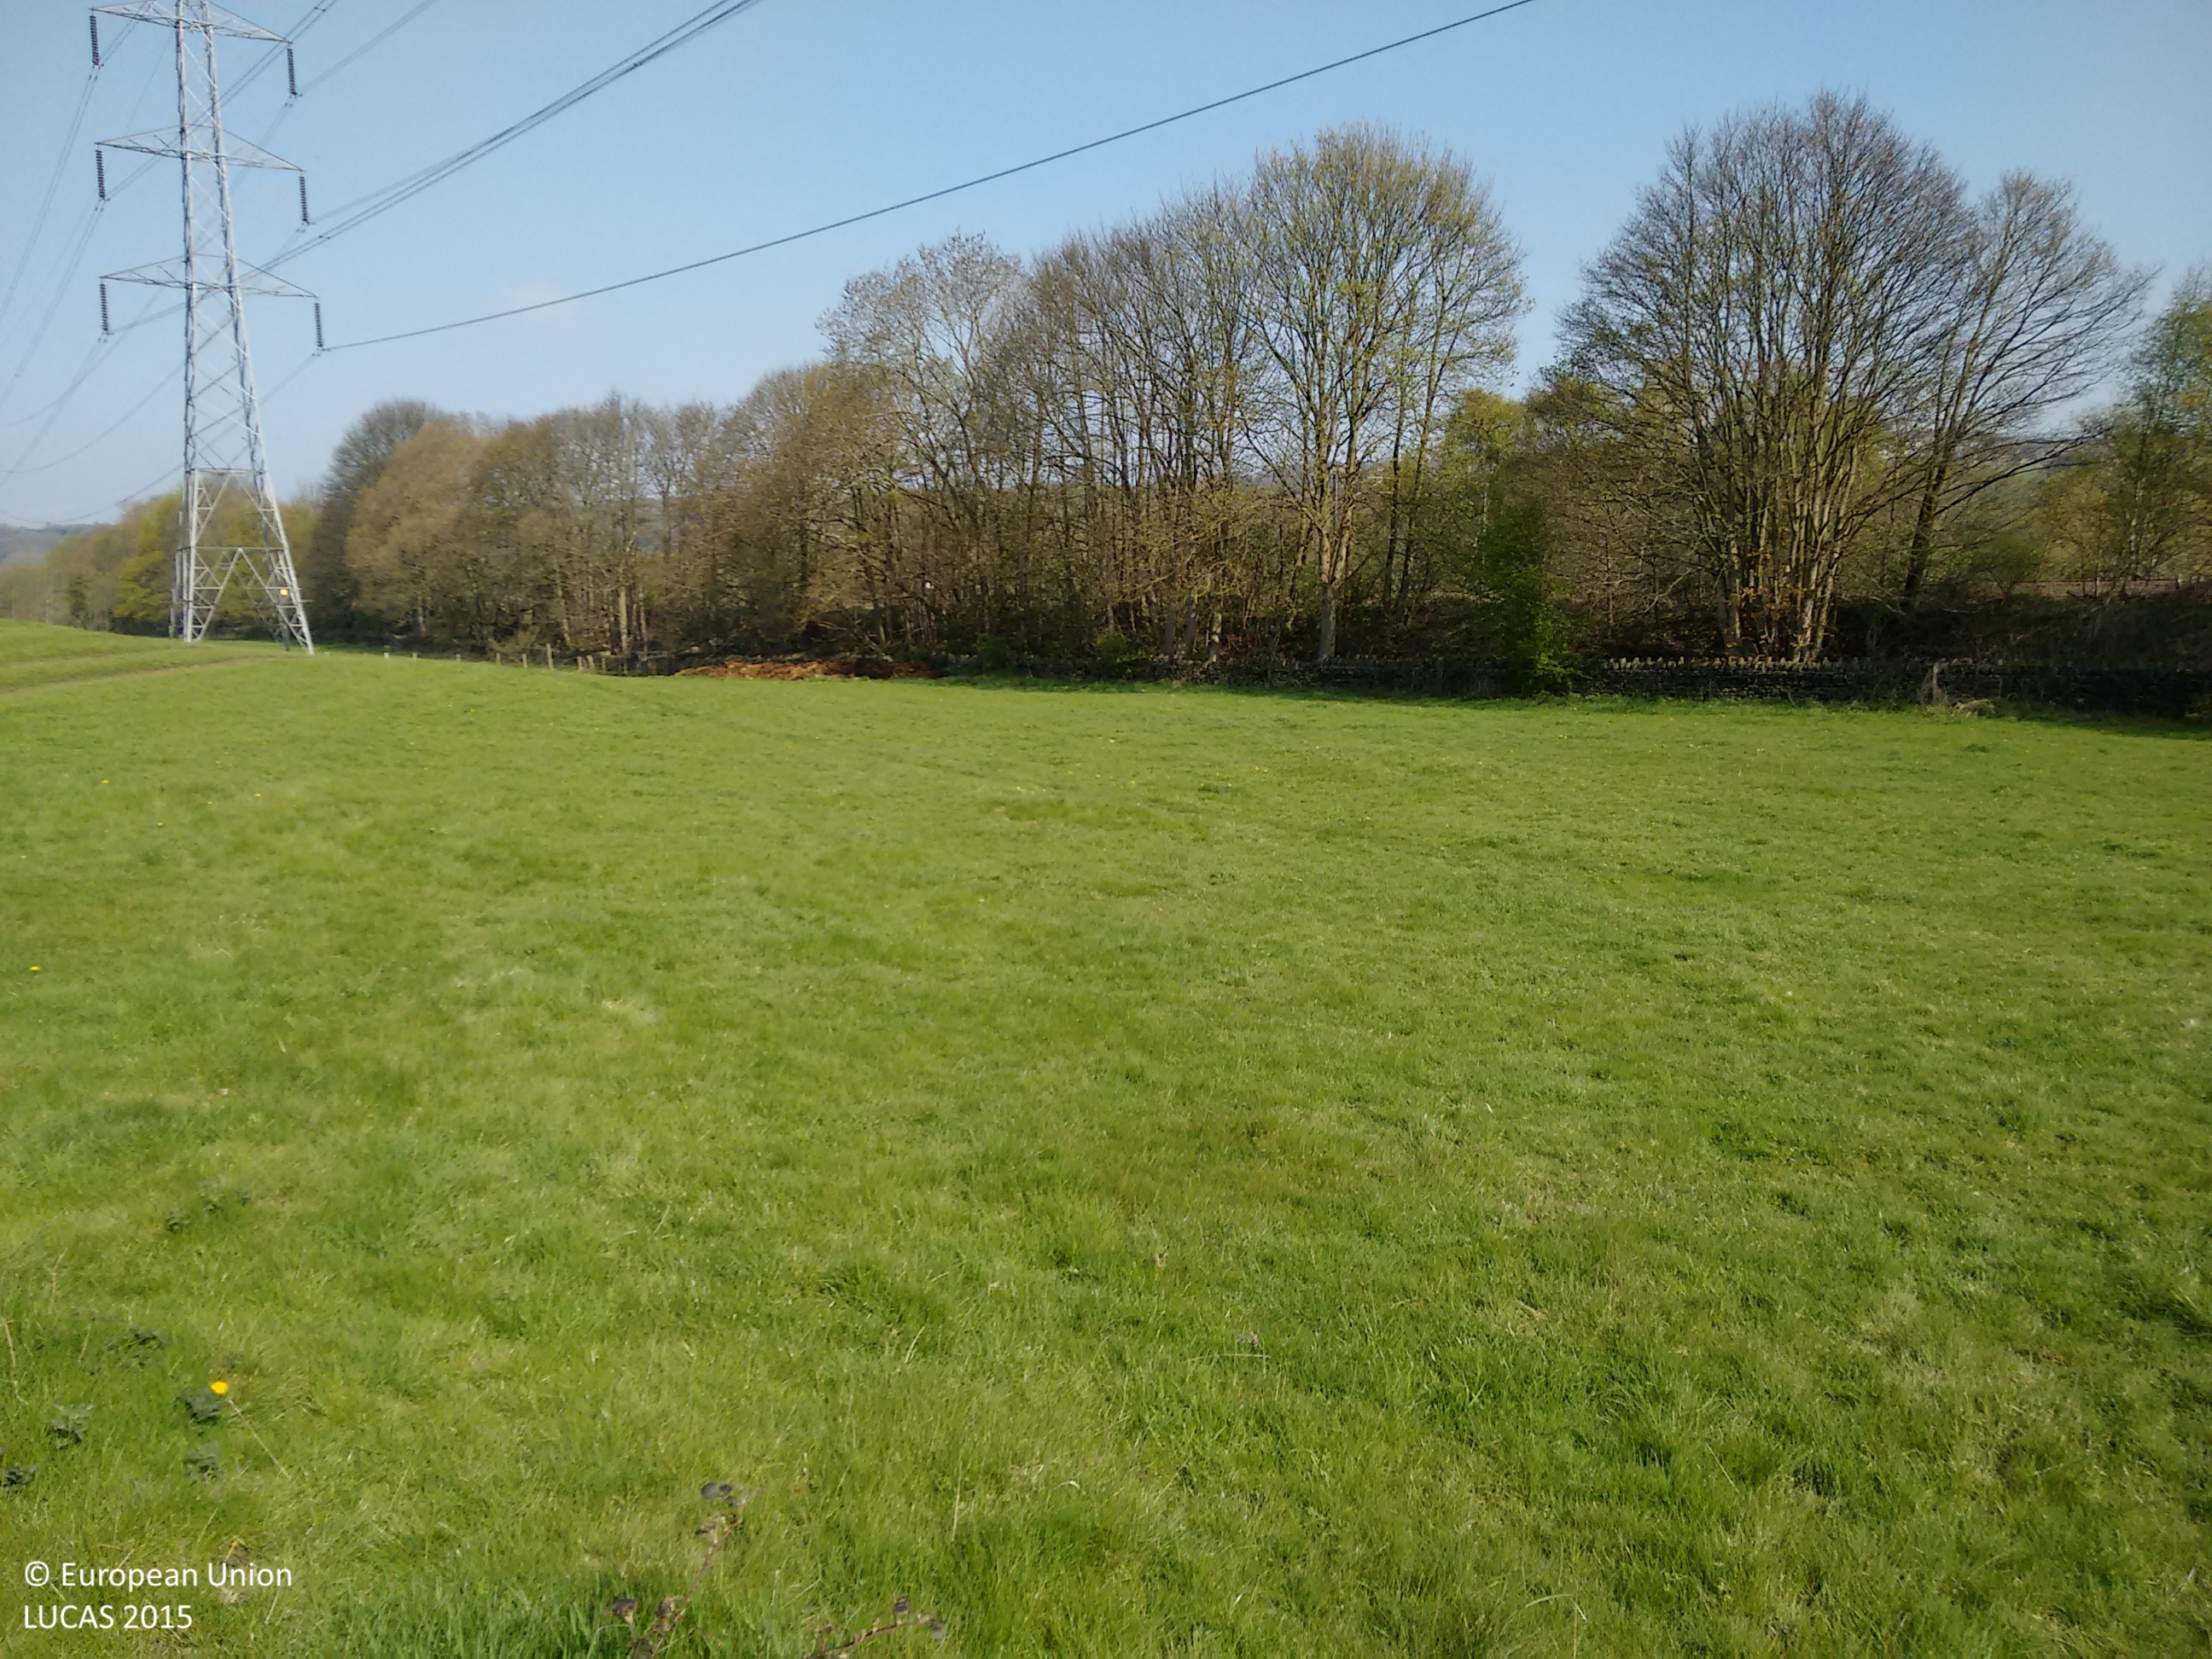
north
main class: Grassland
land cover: Grassland without tree/shrub cover
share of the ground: > 75 %
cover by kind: herbaceous plants 100 %
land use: Agriculture (excluding fallow land and kitchen gardens)
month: April
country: GB
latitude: 53.8344
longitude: -1.6766
